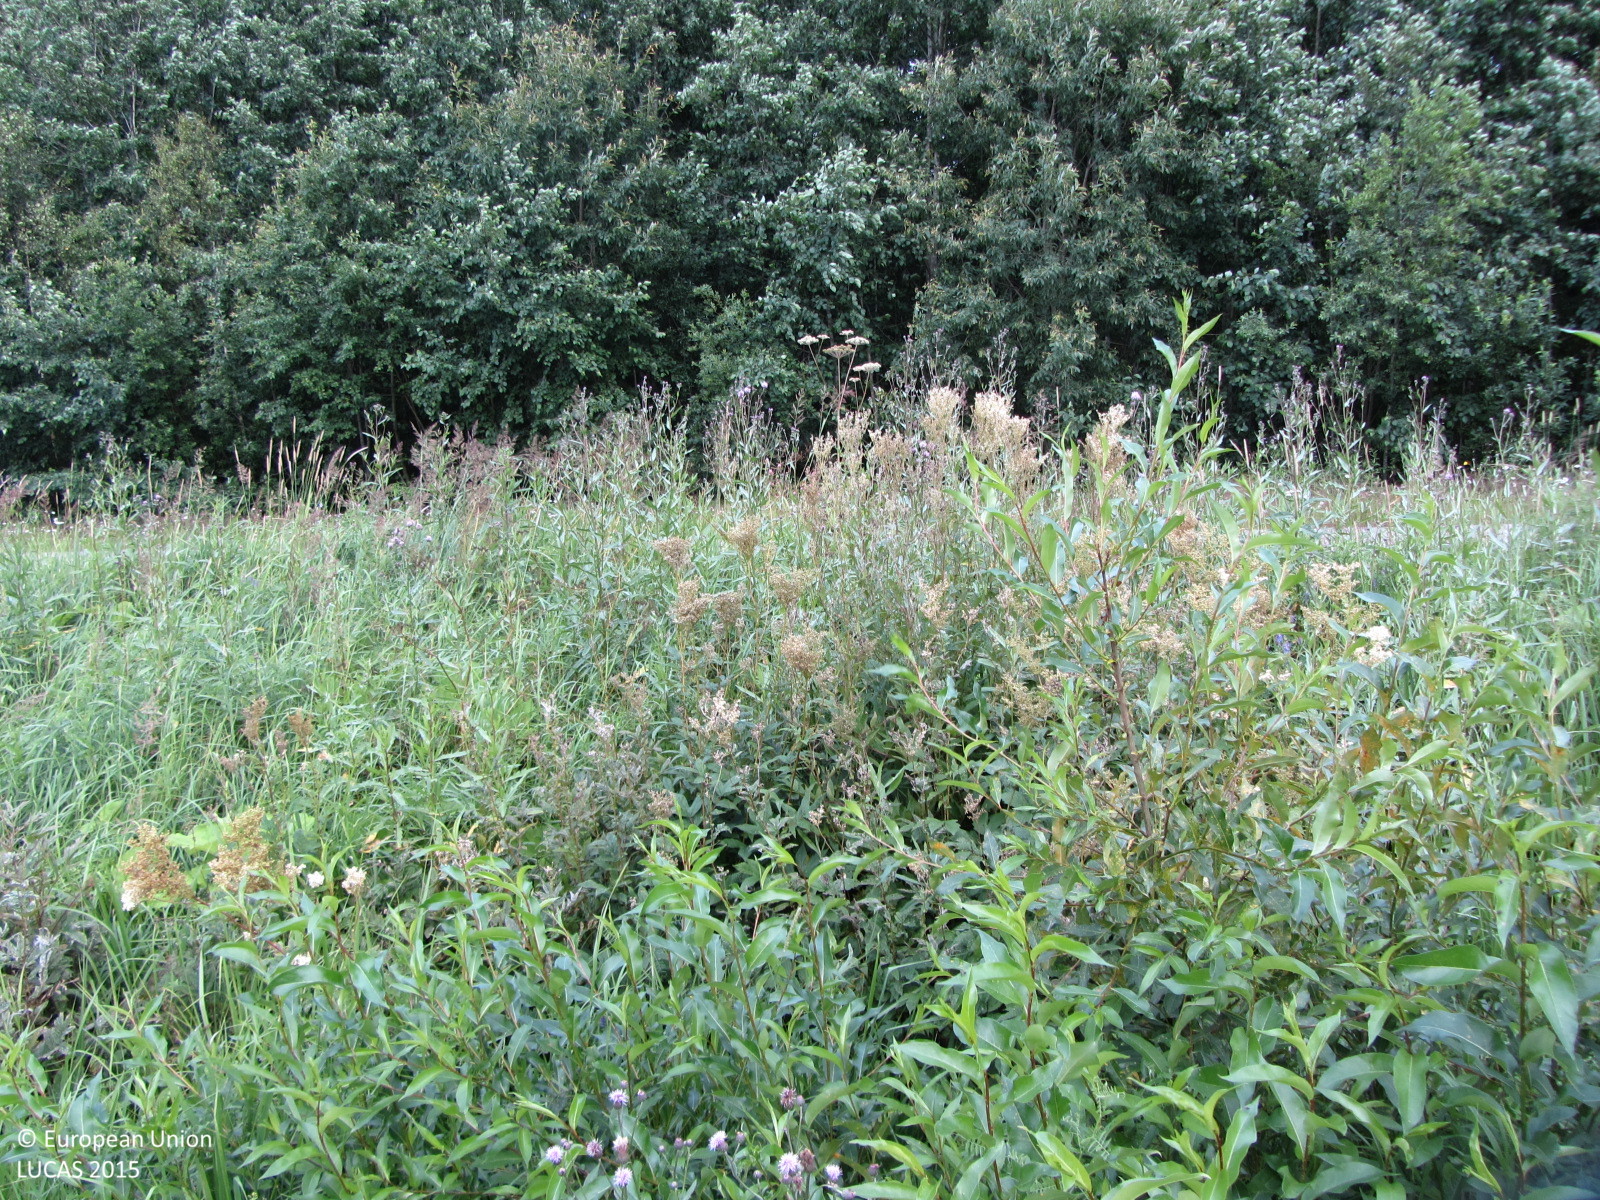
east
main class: Cropland
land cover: Barley
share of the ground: > 75 %
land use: Agriculture (excluding fallow land and kitchen gardens)
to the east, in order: Barley; Grass margins; Ditches and canals; Grass margins; Paved roads, cycling and walking lanes; Grass margins; Broadleaved woodland; Electric lines; Spruce dominated coniferous woodland; Broadleaved woodland; Inland fresh running water; Broadleaved woodland; Spontaneously vegetated surfaces; Broadleaved woodland; Tracks; Broadleaved woodland
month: July
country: FI
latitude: 60.5014
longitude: 24.2102
